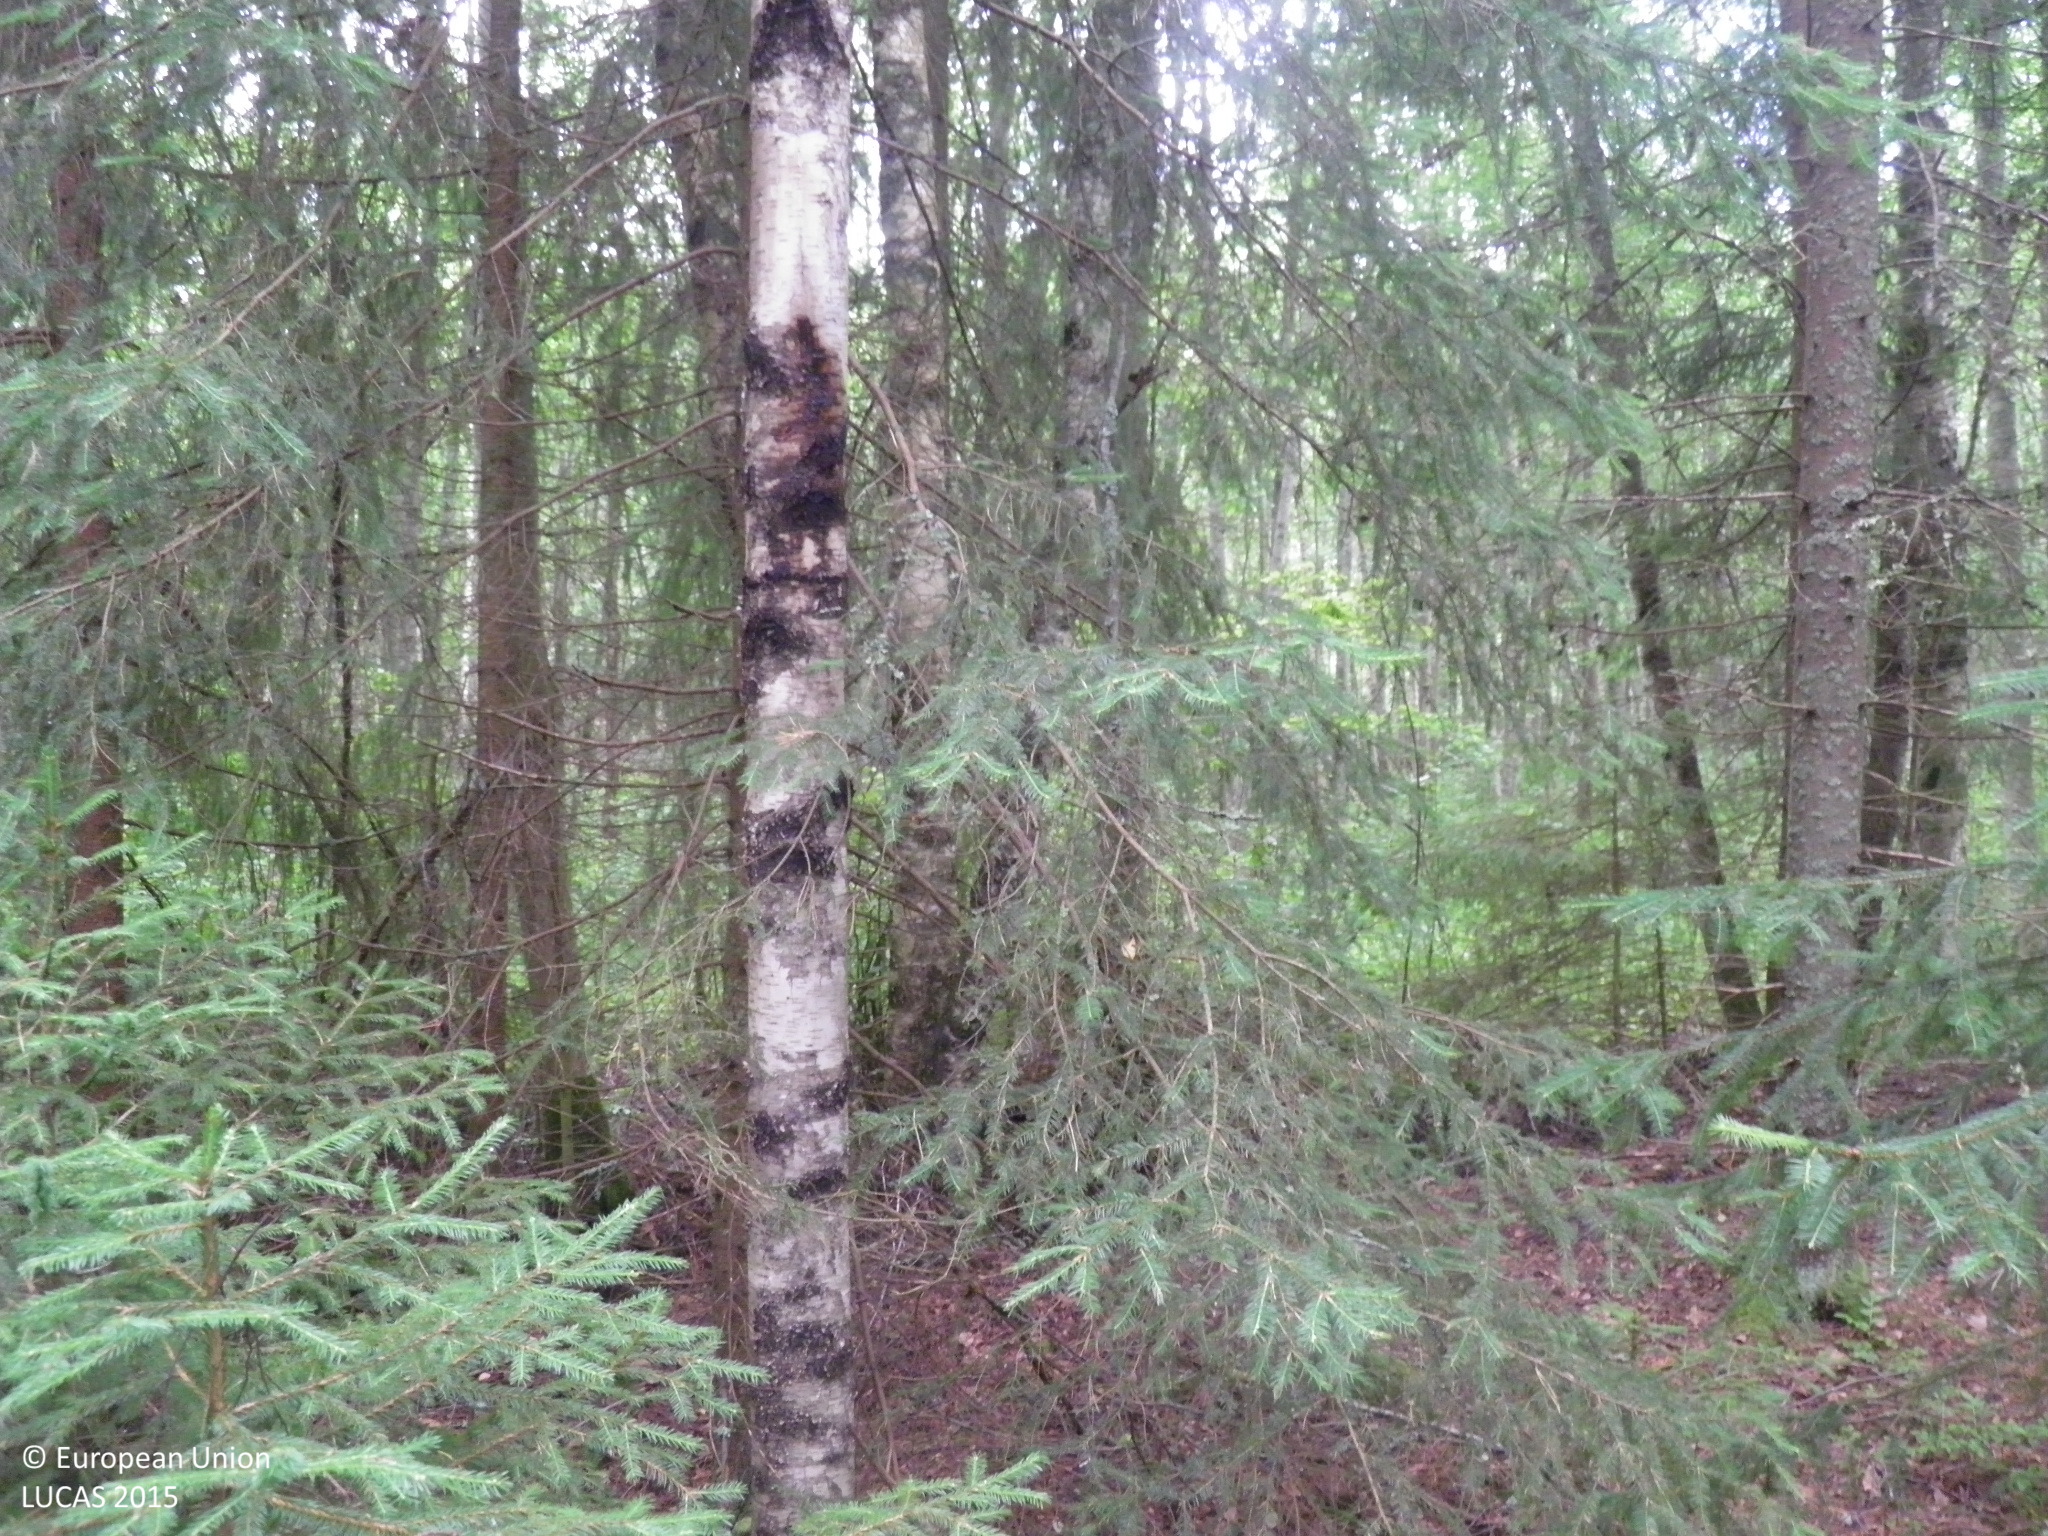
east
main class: Woodland
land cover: Pine dominated mixed woodland
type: hemiboreal forest and nemoral coniferous forest and mixed broadleaved-coniferous forest
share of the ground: 50 - 75 %
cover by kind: broadleaved forest trees 40 %, coniferous forest trees 30 %, shrubs 15 %, herbaceous plants 10 %, lichens and mosses 5 %
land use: Forestry
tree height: > 5 m
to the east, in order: Pine dominated mixed woodland; Broadleaved woodland; Ditches and canals; Broadleaved woodland; Ditches and canals; Broadleaved woodland; Ditches and canals; Other mixed woodland; Ditches and canals; Pine dominated coniferous woodland
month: July
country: FI
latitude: 60.7439
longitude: 22.8223
